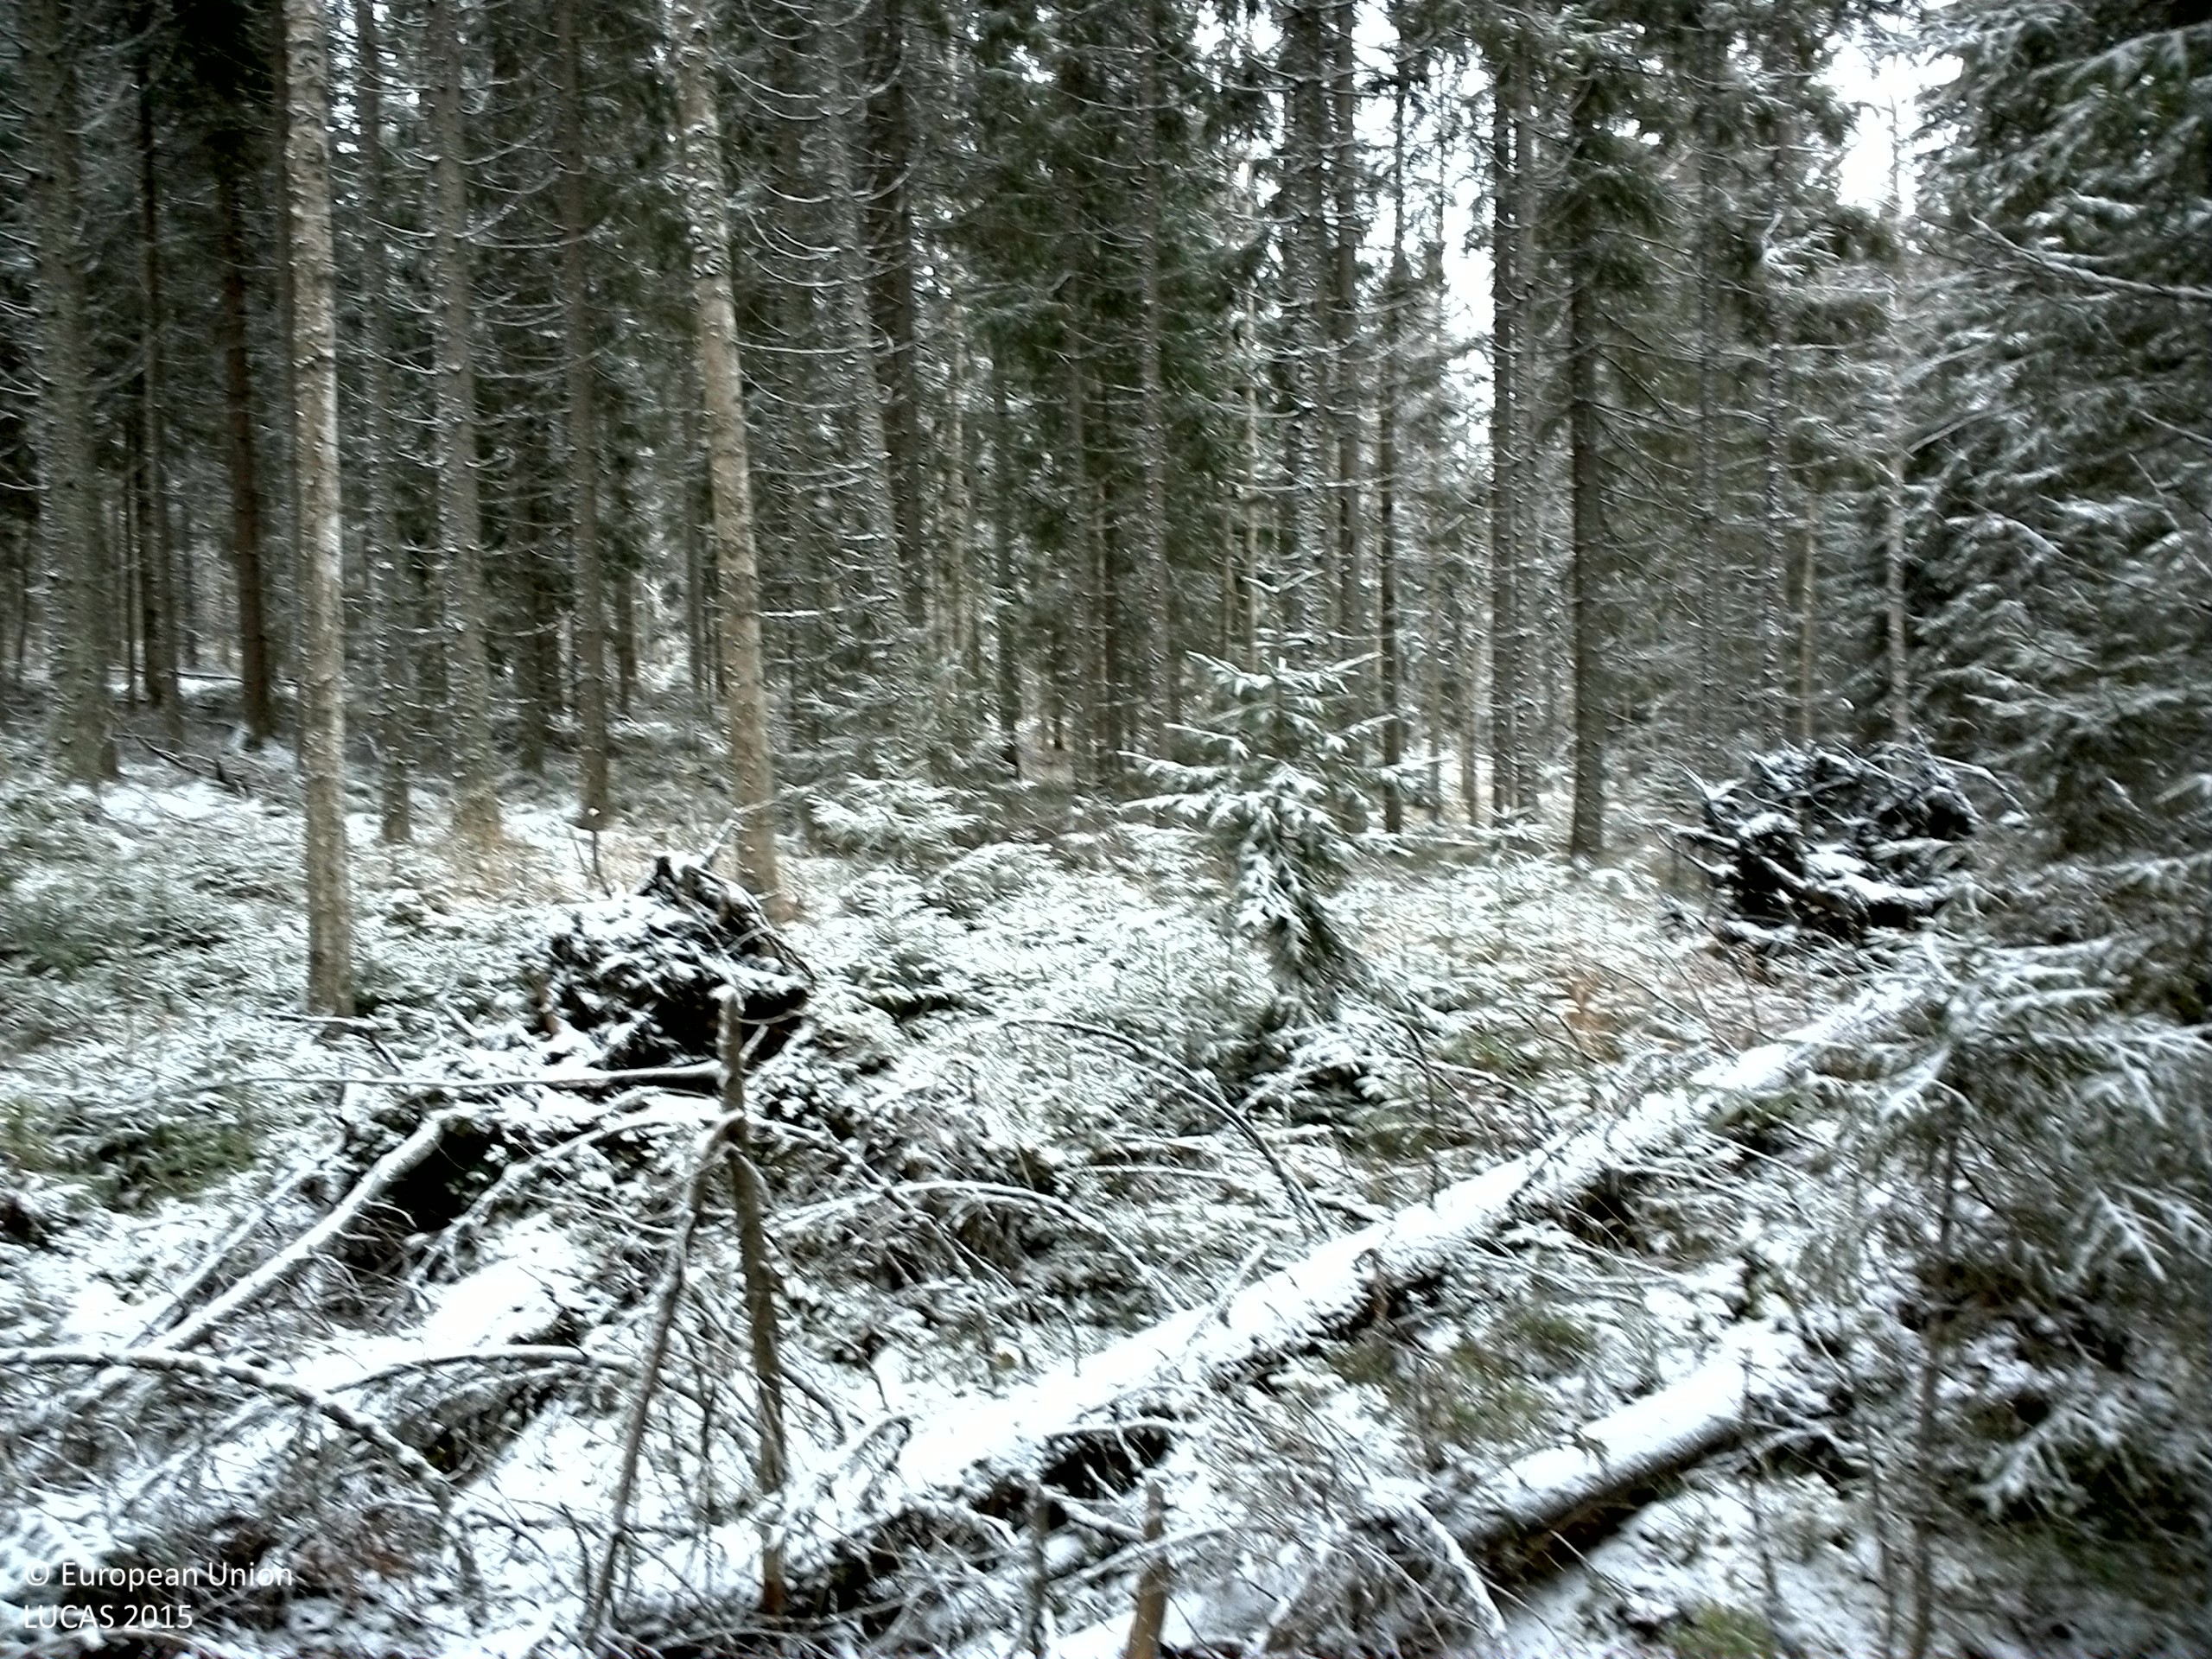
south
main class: Woodland
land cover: Spruce dominated mixed woodland
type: boreal forest
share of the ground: 50 - 75 %
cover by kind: coniferous forest trees 50 %, shrubs 25 %, broadleaved forest trees 20 %, herbaceous plants 5 %
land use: Forestry
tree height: > 5 m
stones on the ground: < 10 %
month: November
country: SE
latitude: 59.9642
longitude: 15.5240
